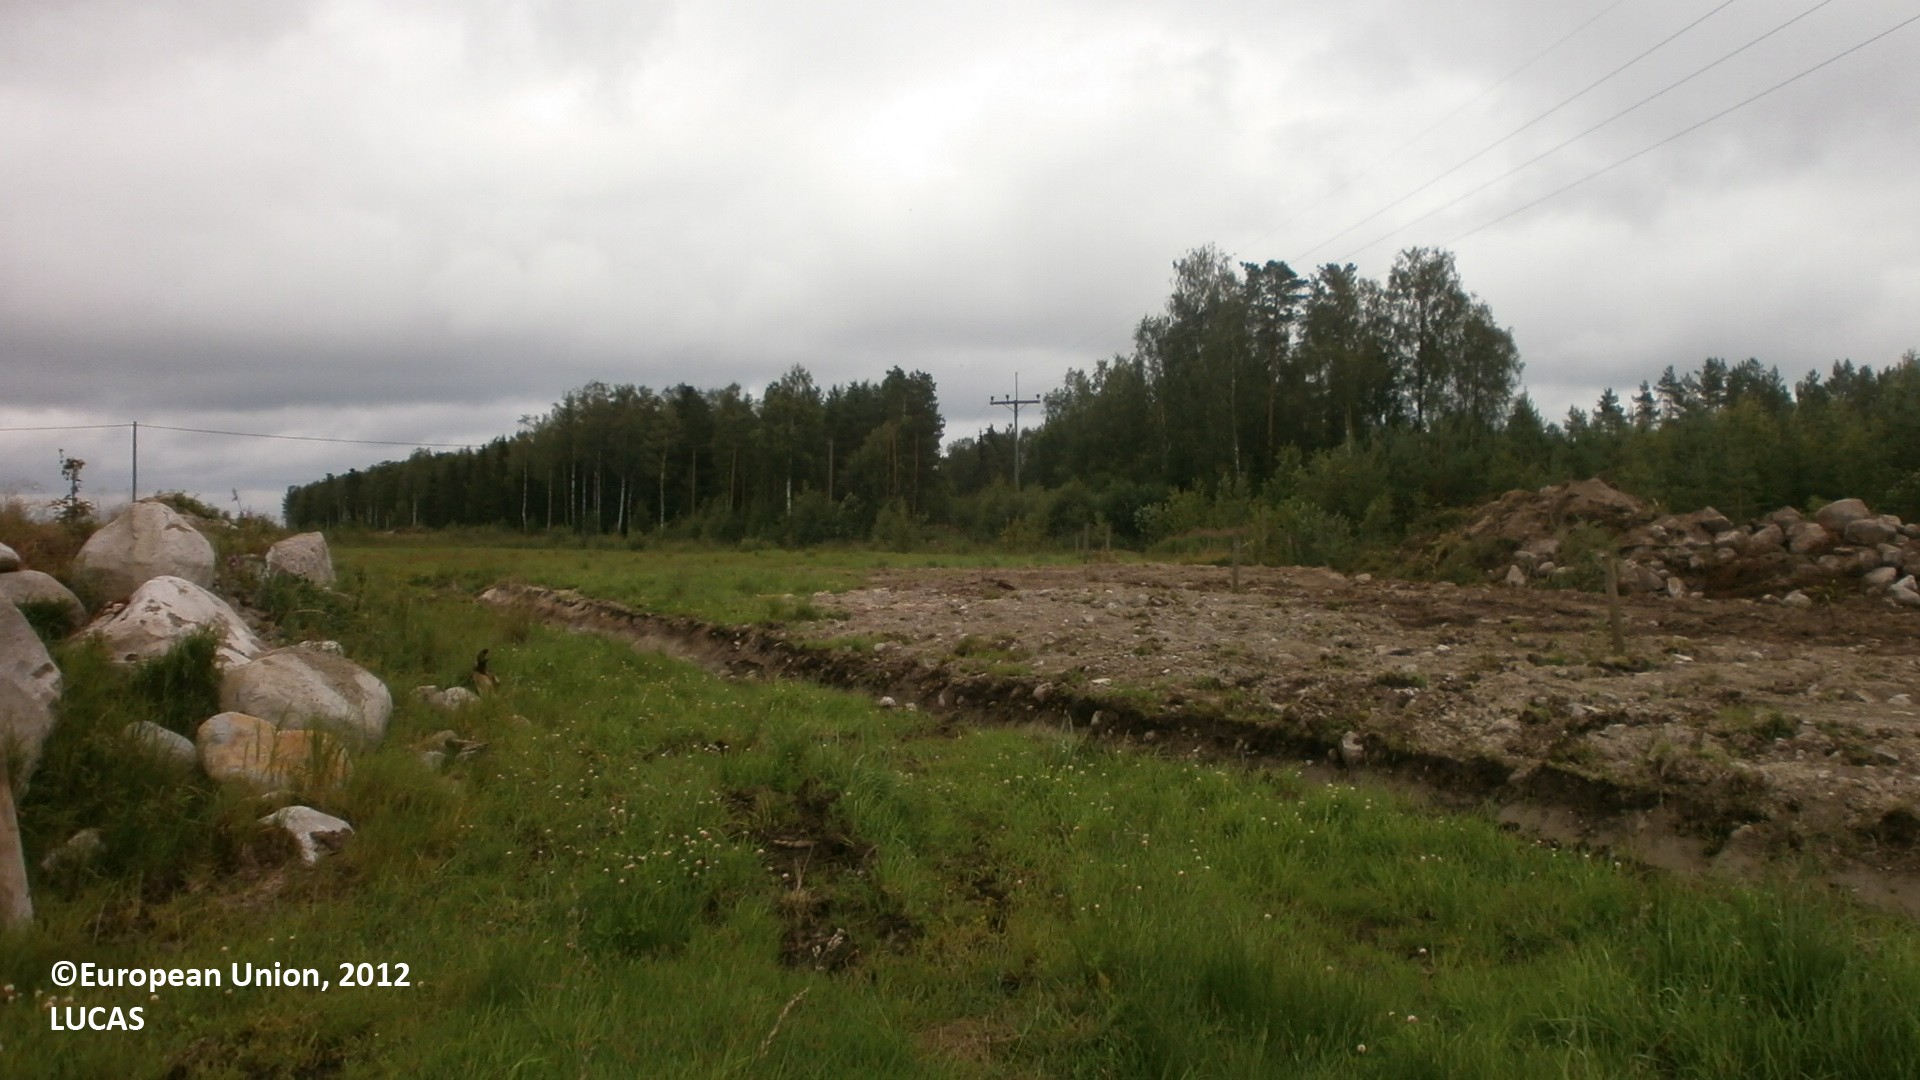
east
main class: Grassland
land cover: Grassland without tree/shrub cover
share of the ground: 50 - 75 %
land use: Agriculture (excluding fallow land and kitchen gardens)
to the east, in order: Grassland without tree/shrub cover; Ditches and canals; Grassland without tree/shrub cover; Electric lines; Grassland without tree/shrub cover; Shruby margins; Ditches and canals; Tracks; Fences; Shruby margins; Ditches and canals; Pine dominated mixed woodland; Spruce dominated mixed woodland; Ditches and canals; Other mixed woodland
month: July
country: FI
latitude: 64.2070
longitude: 24.0923
